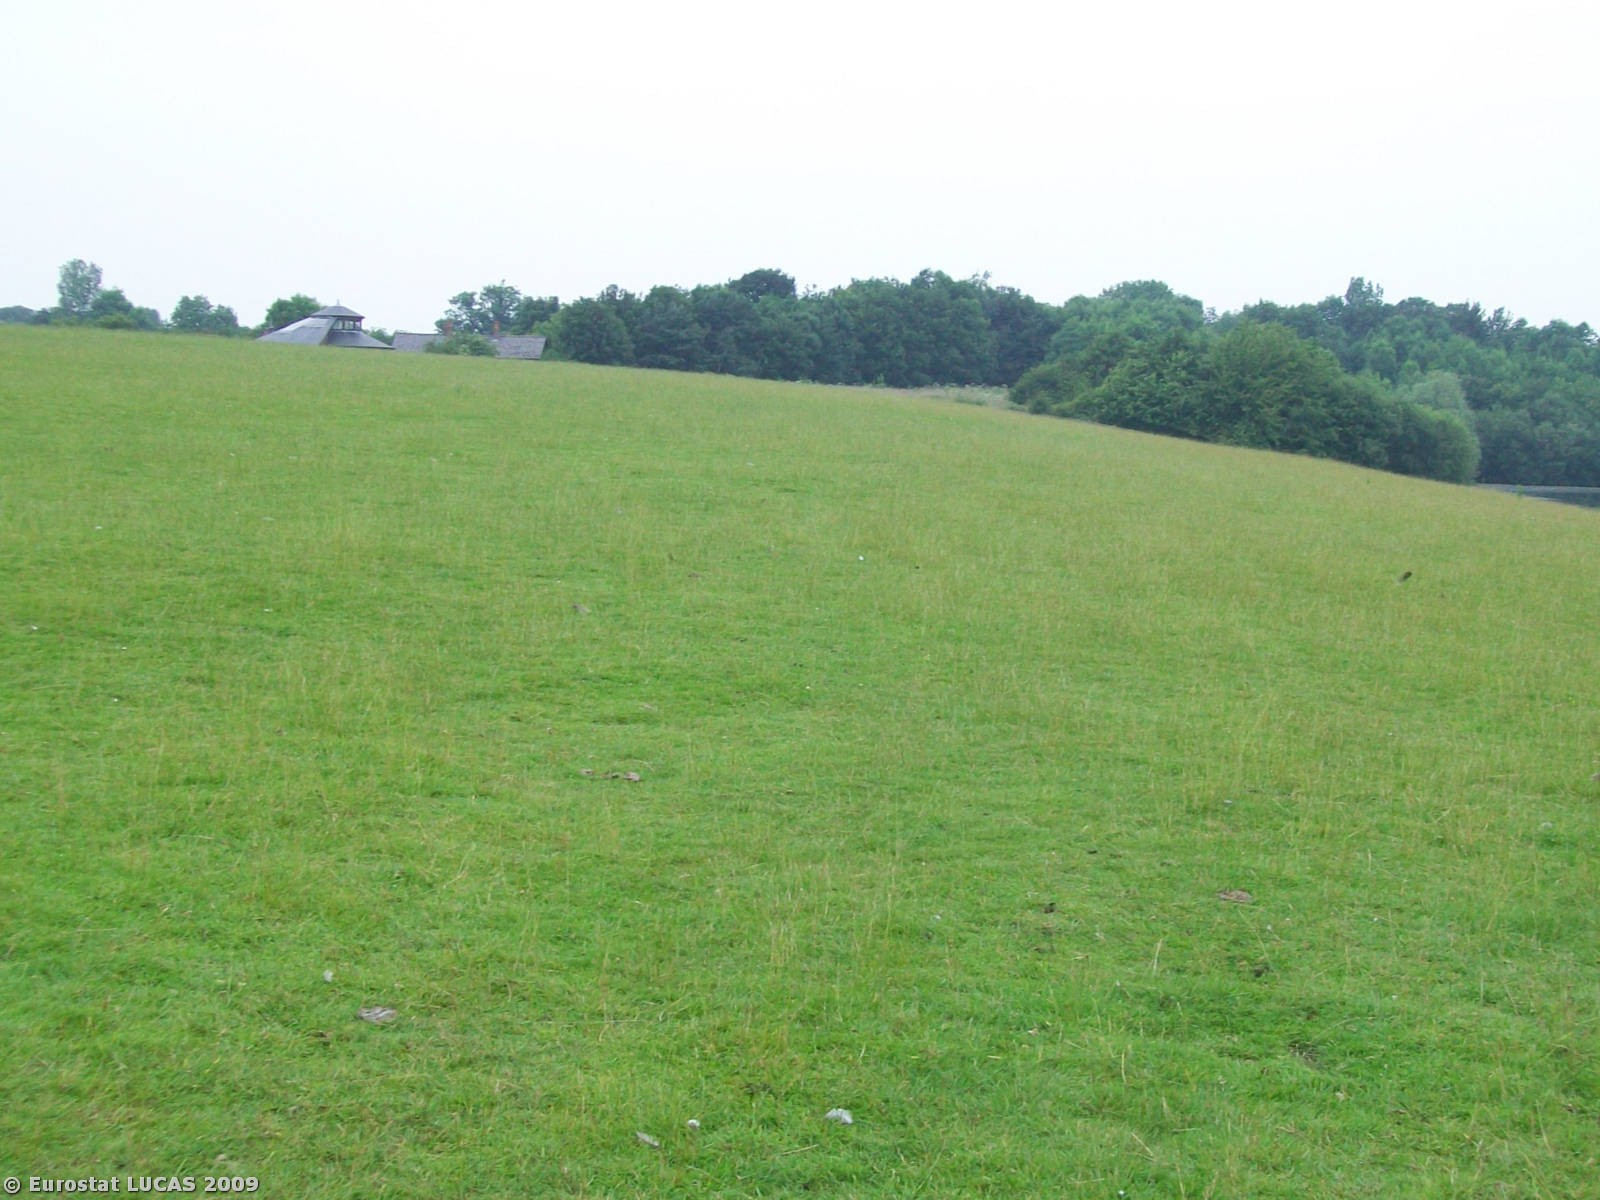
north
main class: Grassland
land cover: Grassland without tree/shrub cover
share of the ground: < 10 %
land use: Agriculture (excluding fallow land and kitchen gardens)
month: June
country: GB
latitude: 54.0195
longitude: -1.4499
